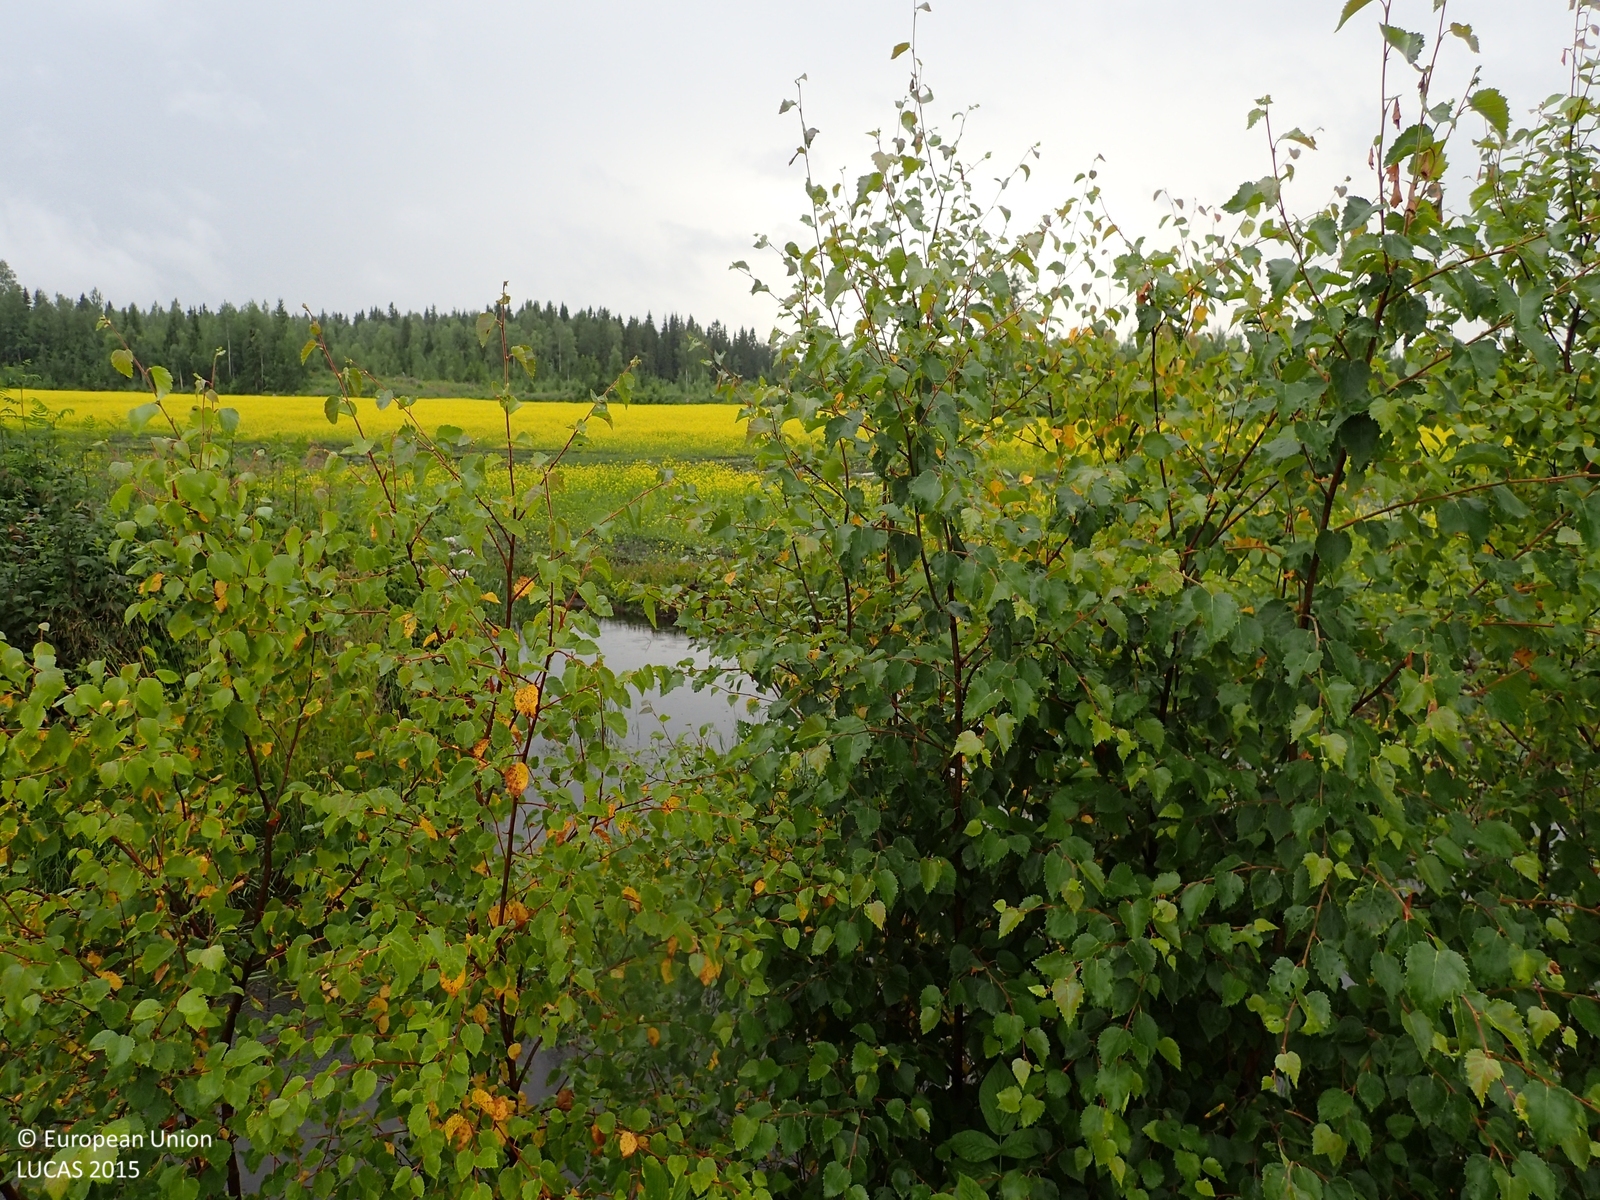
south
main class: Cropland
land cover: Rape and turnip rape
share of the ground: > 75 %
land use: Agriculture (excluding fallow land and kitchen gardens)
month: July
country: FI
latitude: 63.0145
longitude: 22.5962
